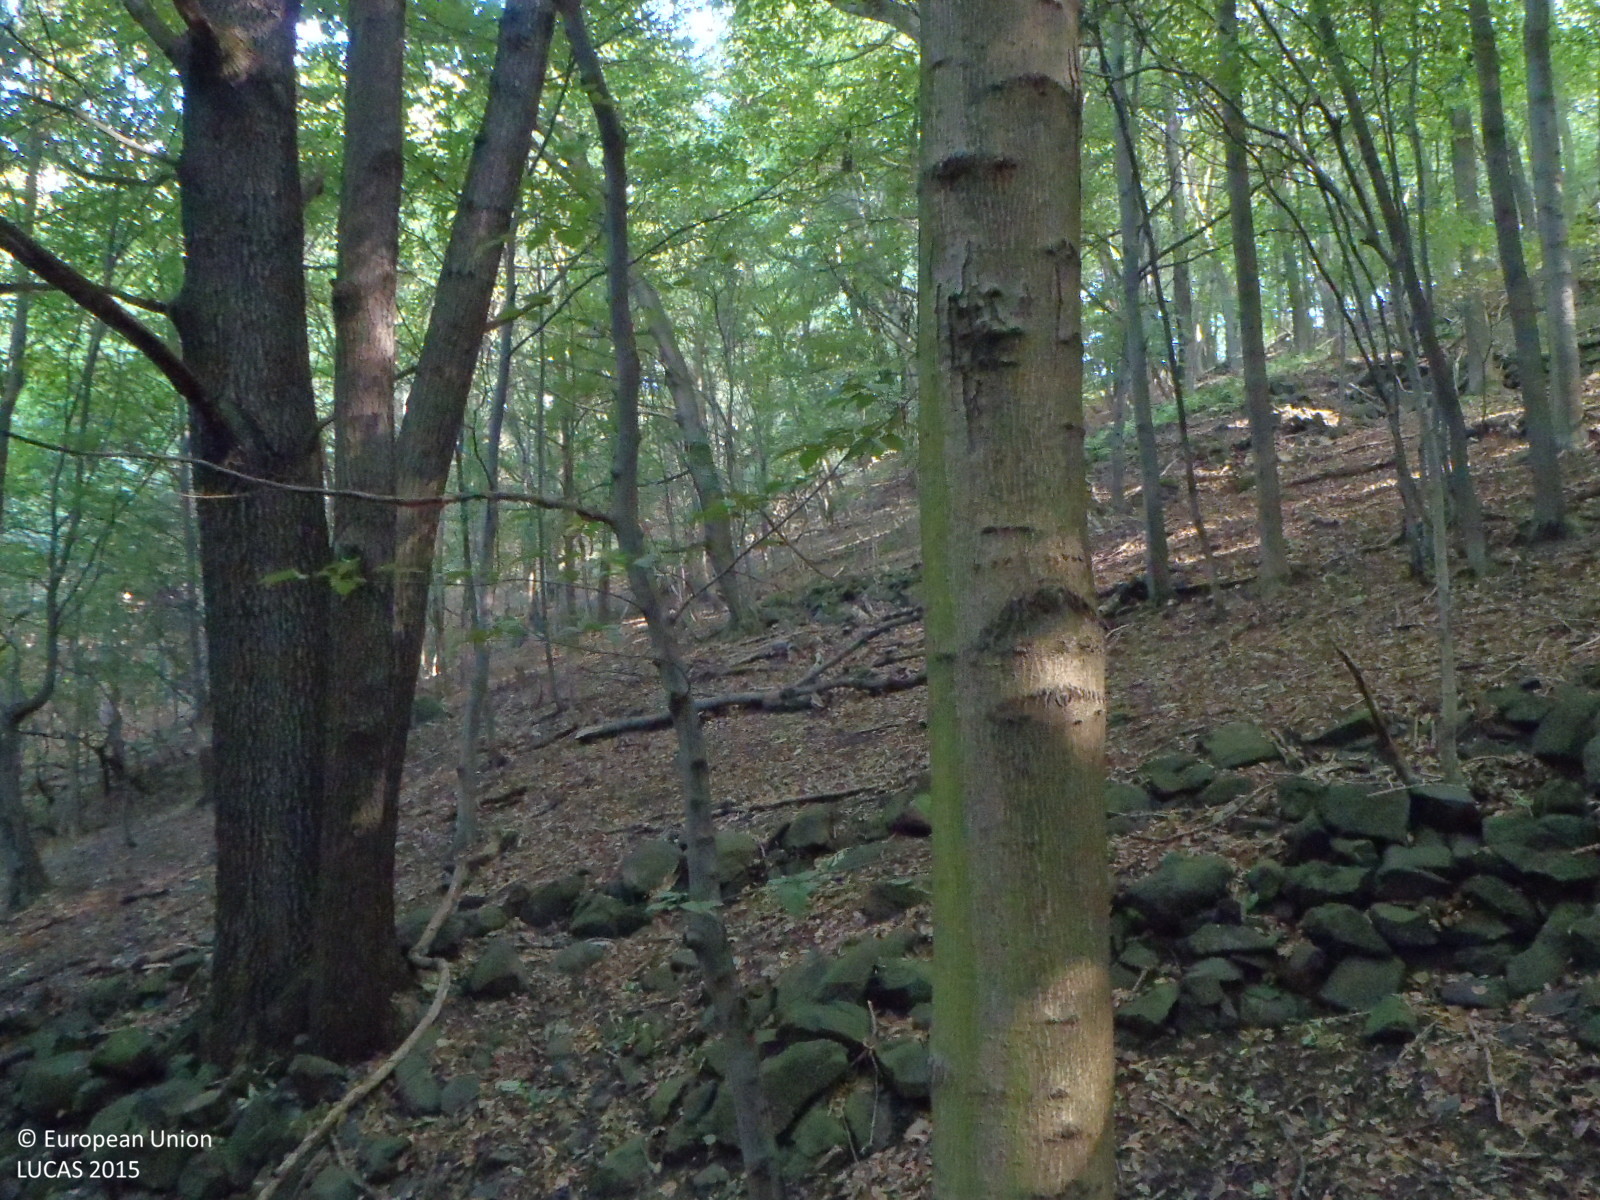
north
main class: Woodland
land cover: Broadleaved woodland
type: mesophytic deciduous forest
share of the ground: > 75 %
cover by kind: broadleaved forest trees 100 %
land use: Forestry
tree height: > 5 m
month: September
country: CZ
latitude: 50.6511
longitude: 14.0886
